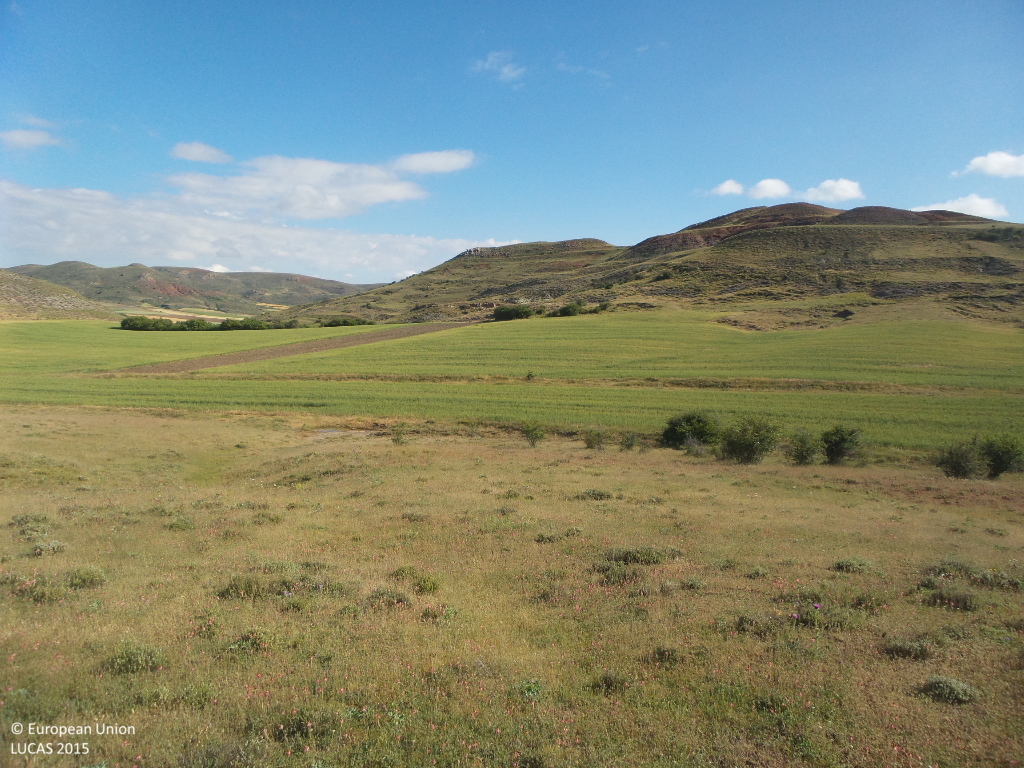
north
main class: Grassland
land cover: Grassland without tree/shrub cover
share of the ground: > 75 %
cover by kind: herbaceous plants 80 %, unconsolidated bare surface 15 %, shrubs 5 %
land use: Abandoned areas
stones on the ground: < 10 %
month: June
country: ES
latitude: 41.3094
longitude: -3.0717
